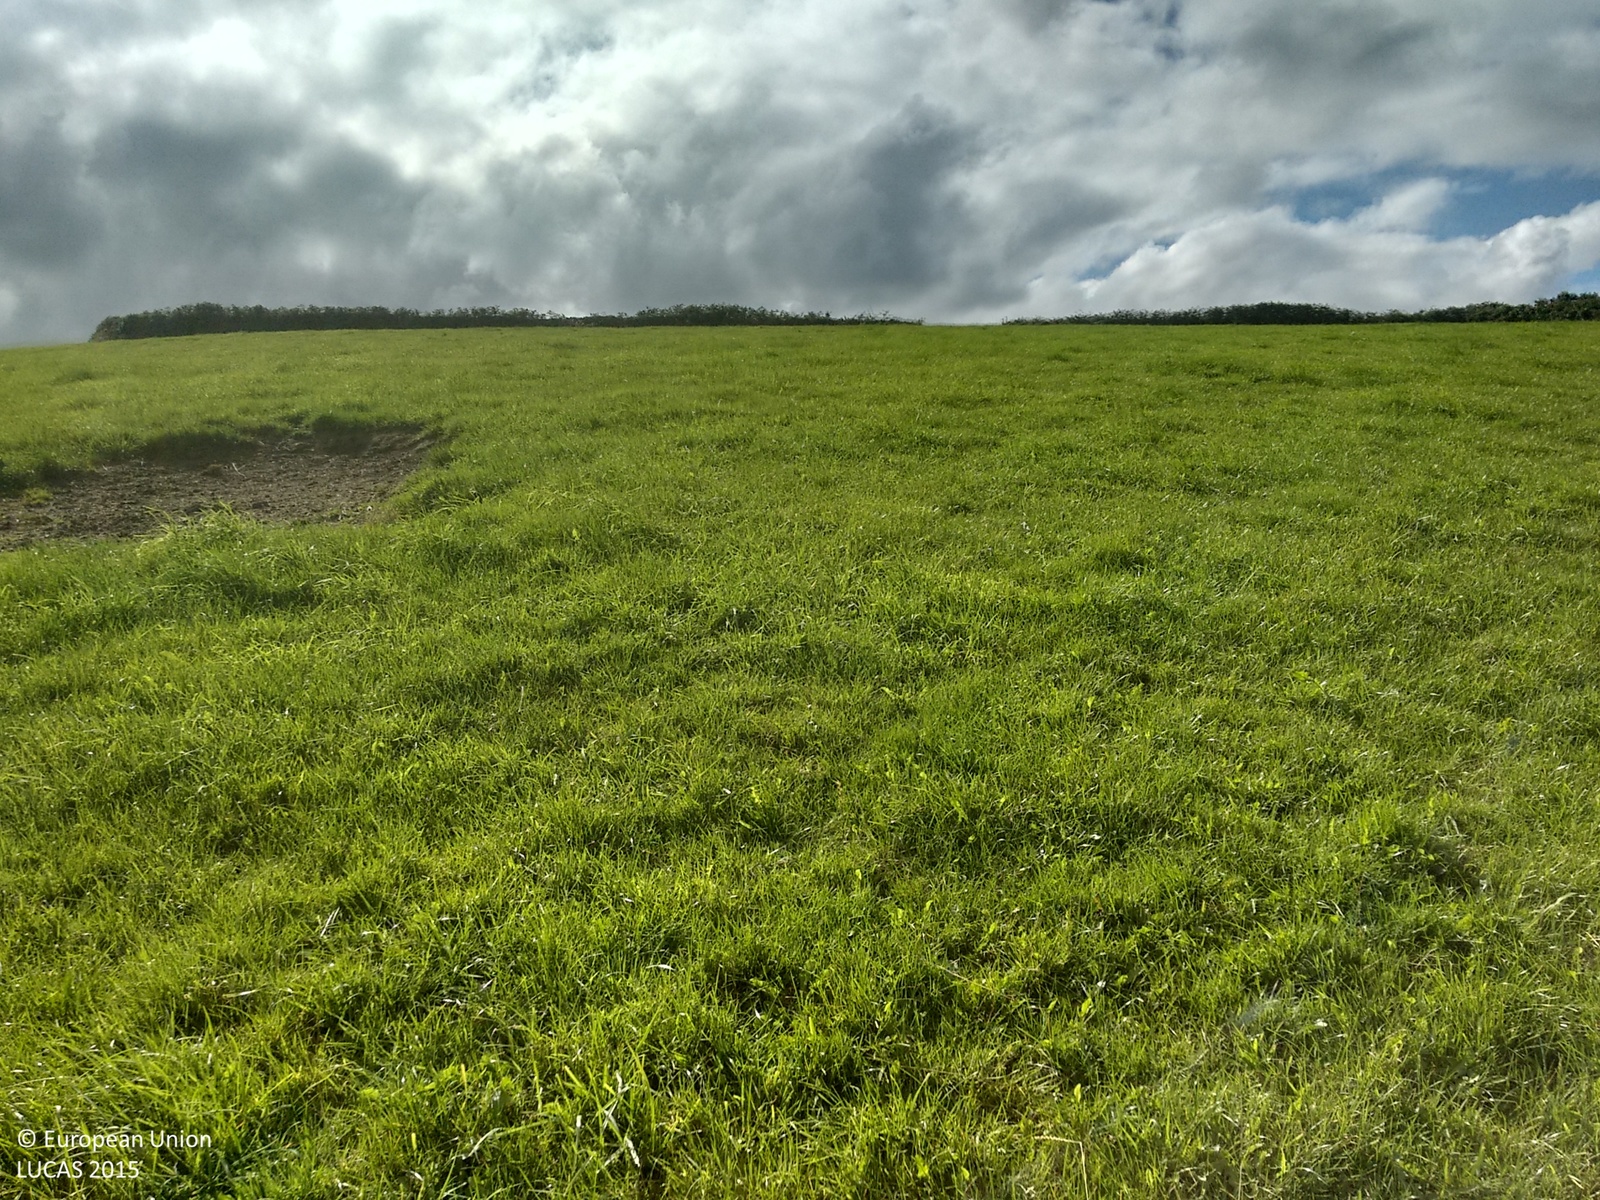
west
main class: Grassland
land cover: Grassland without tree/shrub cover
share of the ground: > 75 %
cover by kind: herbaceous plants 100 %
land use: Agriculture (excluding fallow land and kitchen gardens)
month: September
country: GB
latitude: 50.2031
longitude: -5.1810
